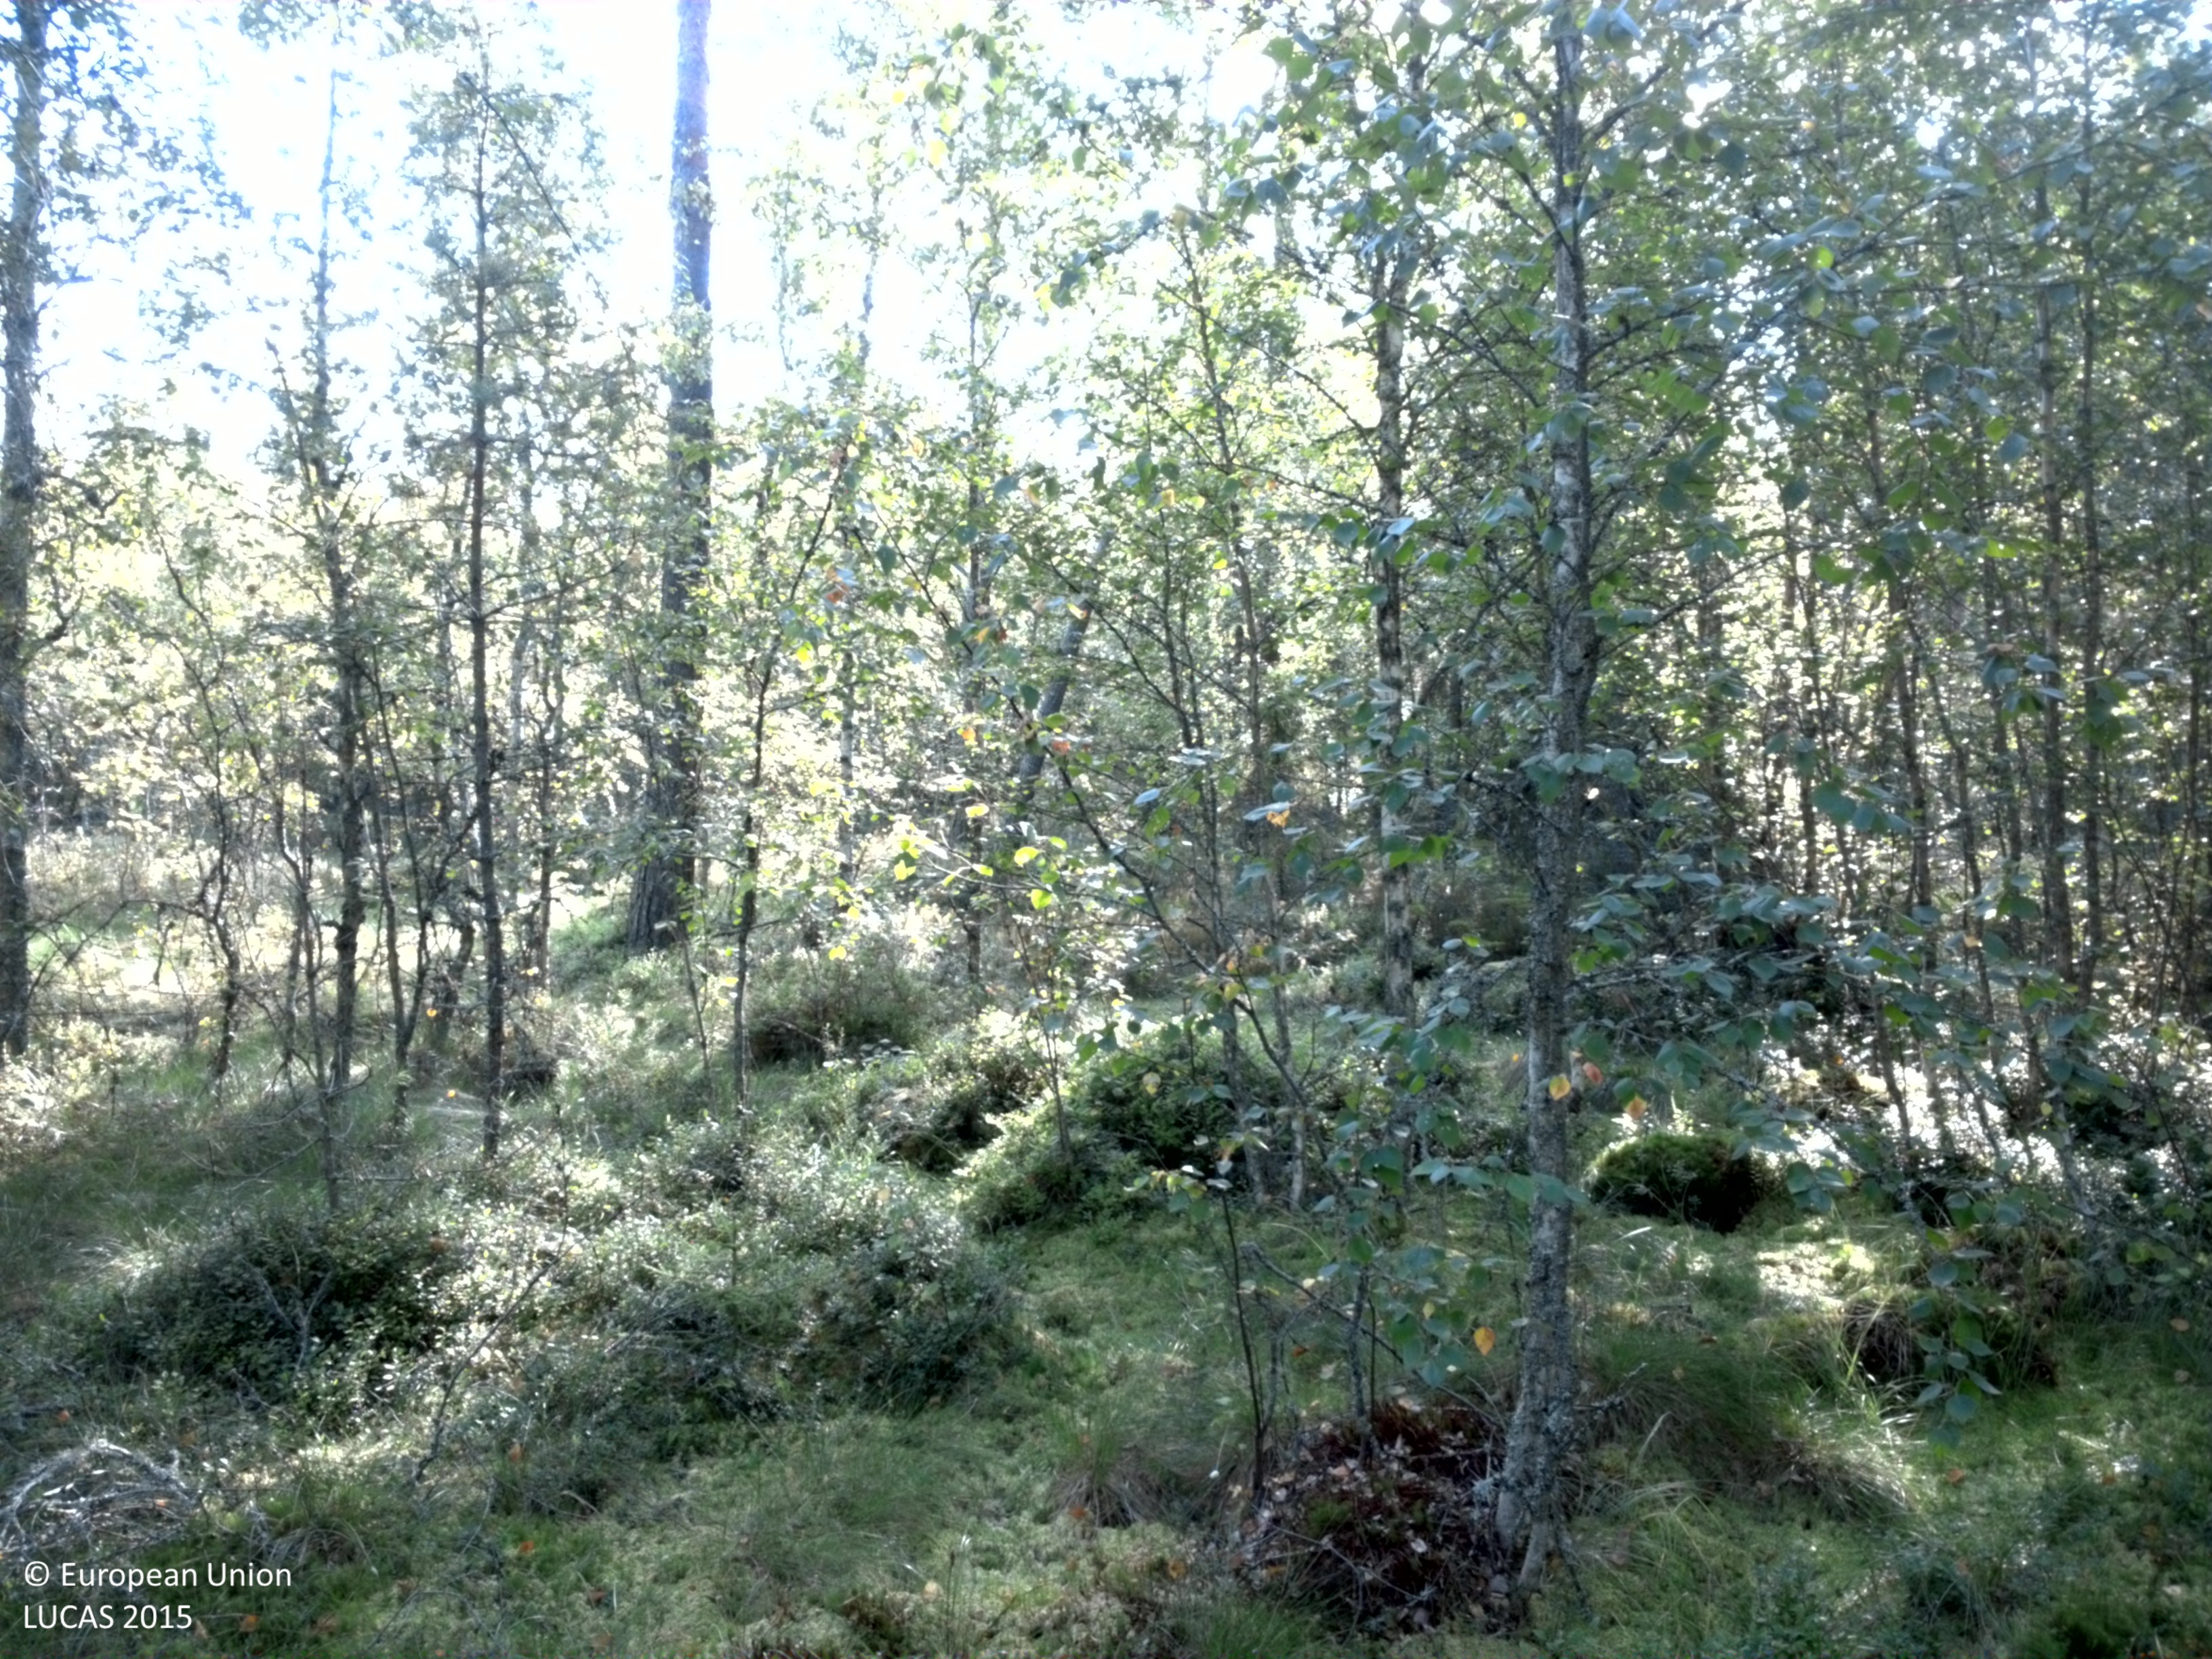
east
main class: Woodland
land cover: Pine dominated coniferous woodland
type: boreal forest
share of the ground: 50 - 75 %
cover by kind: coniferous forest trees 60 %, lichens and mosses 25 %, broadleaved forest trees 15 %
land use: Forestry
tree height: > 5 m
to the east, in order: Pine dominated coniferous woodland; Broadleaved woodland; Pine dominated coniferous woodland; Tracks; Pine dominated coniferous woodland; Tracks; Pine dominated coniferous woodland; Tracks; Pine dominated coniferous woodland
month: August
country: SE
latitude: 60.0190
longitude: 17.7984
